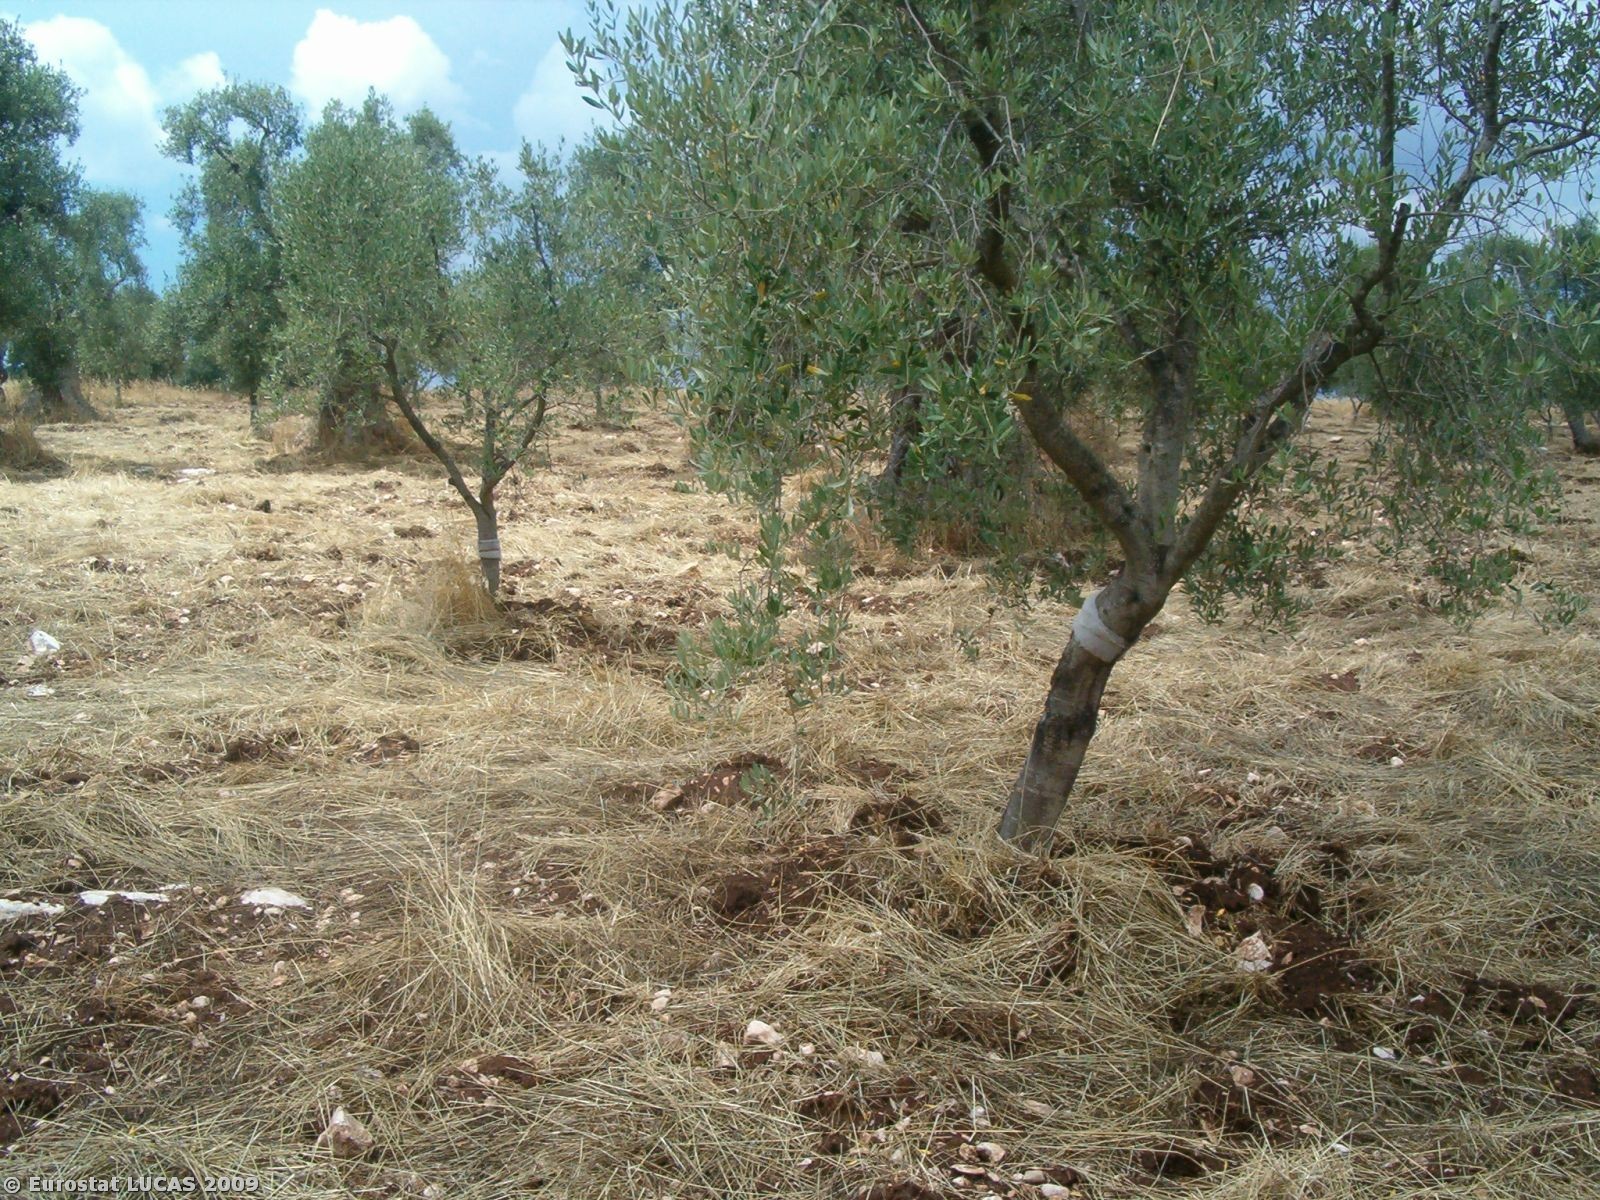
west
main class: Cropland
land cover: Olive groves
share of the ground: 50 - 75 %
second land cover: Grassland with sparse tree/shrub cover
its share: 50 - 75 %
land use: Agriculture (excluding fallow land and kitchen gardens)
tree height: < 5 m
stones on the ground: 25 - 50 %
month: June
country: IT
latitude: 40.4875
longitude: 17.5144
